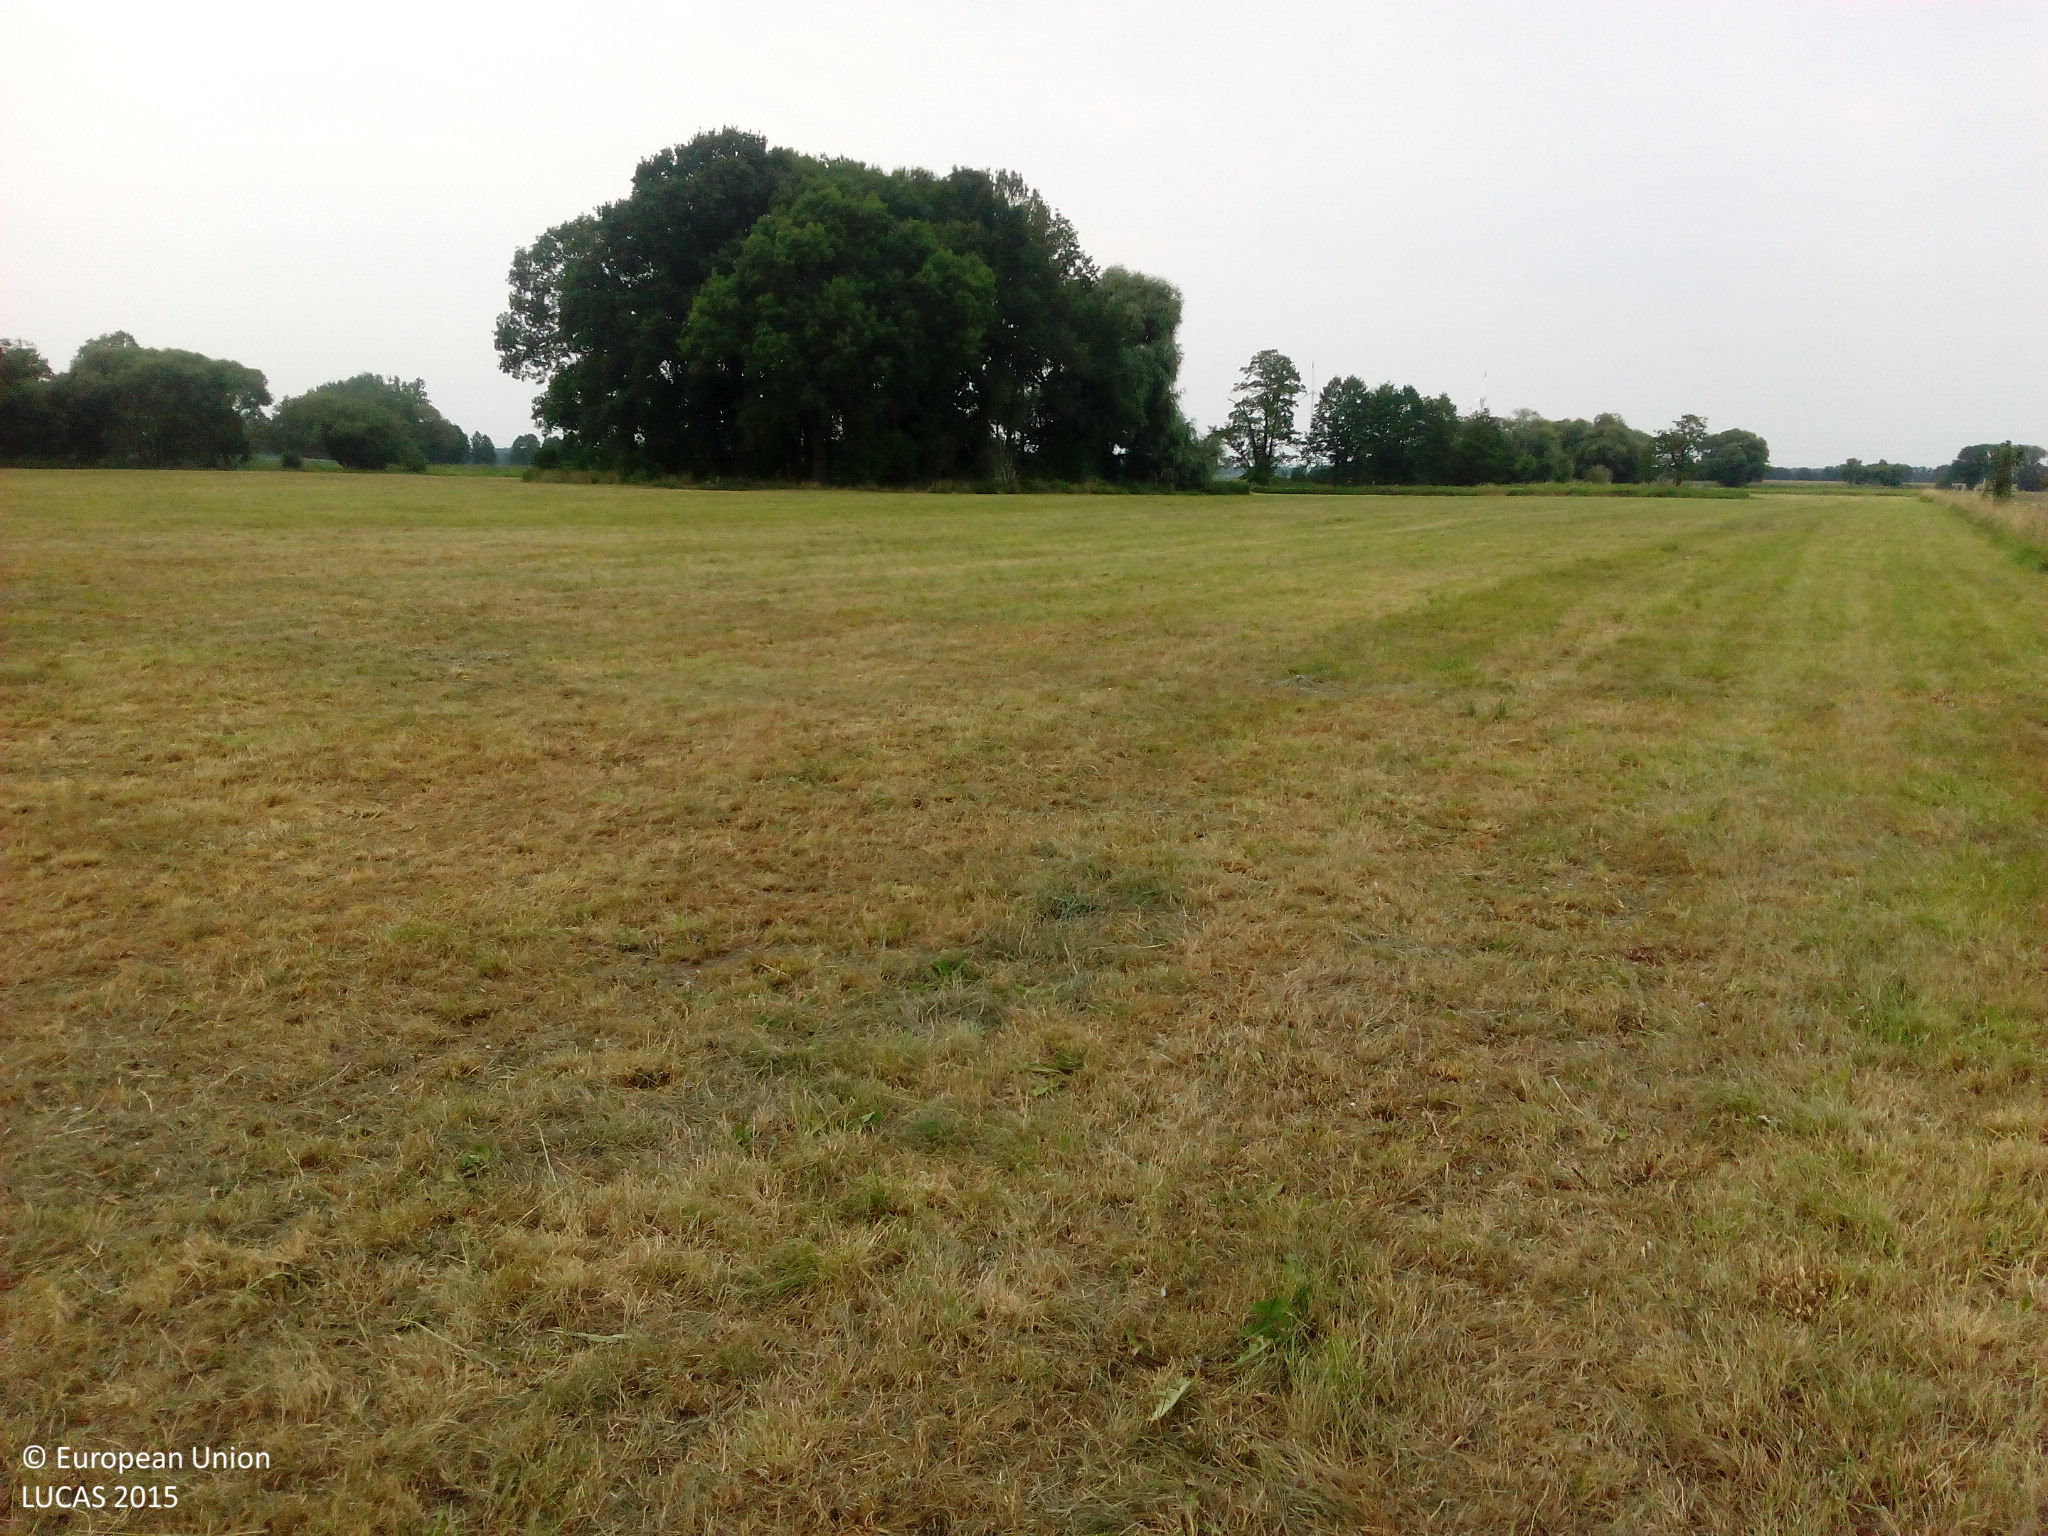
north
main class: Grassland
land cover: Grassland without tree/shrub cover
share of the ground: > 75 %
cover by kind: herbaceous plants 100 %
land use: Agriculture (excluding fallow land and kitchen gardens)
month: August
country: DE
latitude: 51.8141
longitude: 13.1478
